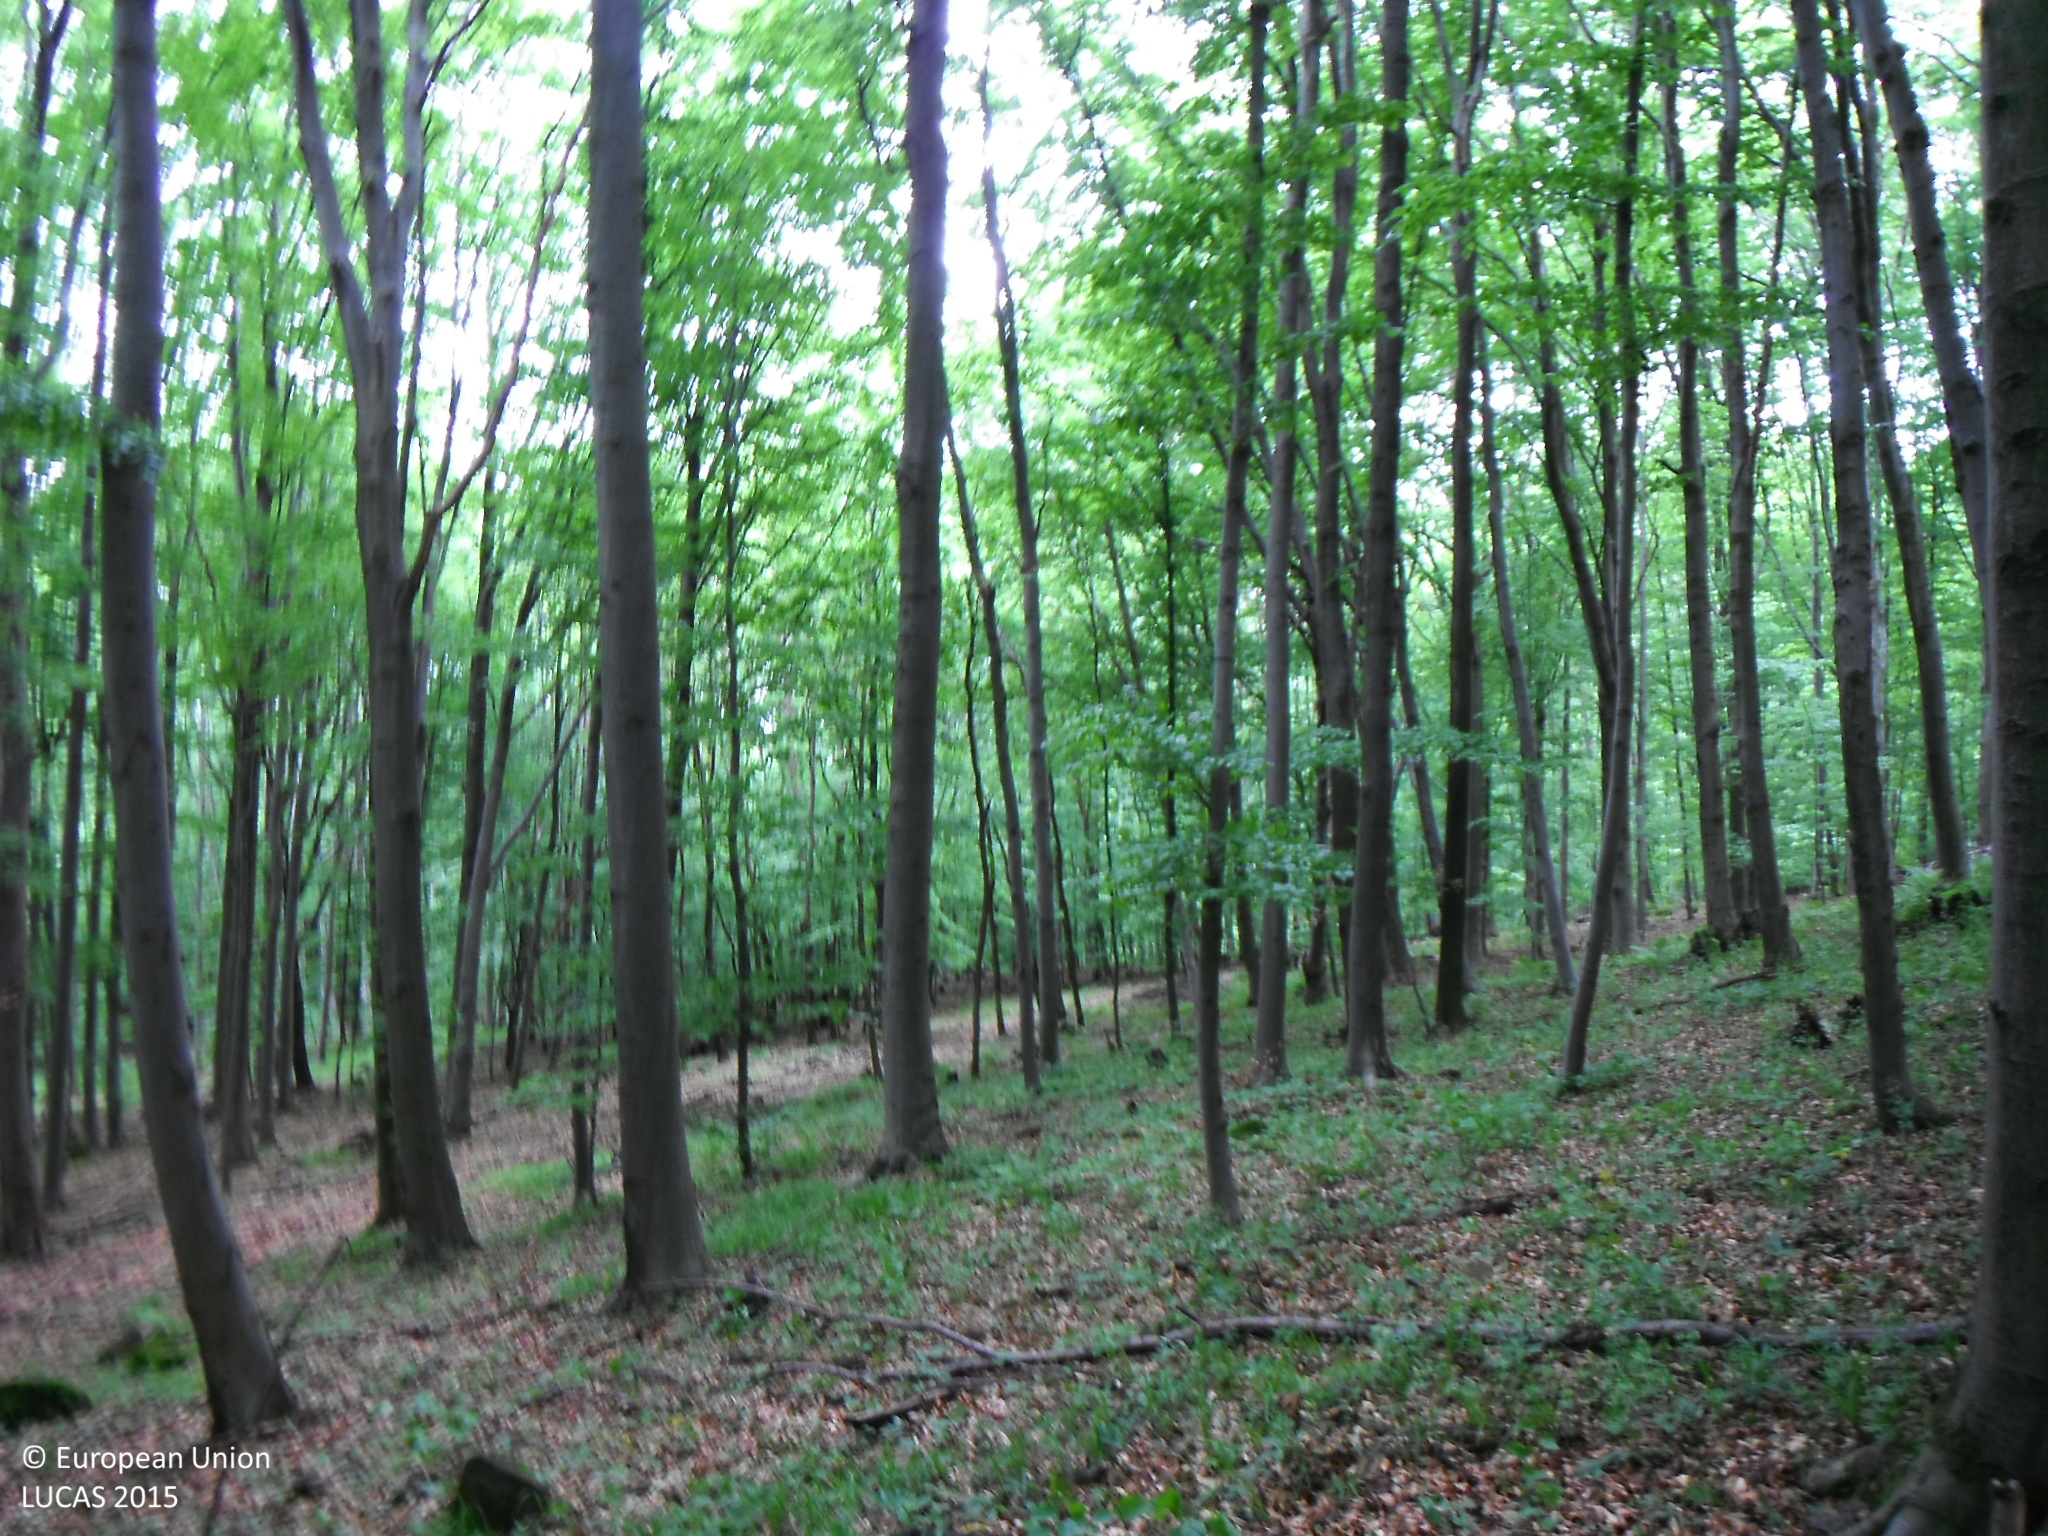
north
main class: Woodland
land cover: Broadleaved woodland
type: beech forest
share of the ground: > 75 %
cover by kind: broadleaved forest trees 100 %
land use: Forestry
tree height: > 5 m
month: May
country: SK
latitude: 48.9801
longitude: 21.3459
